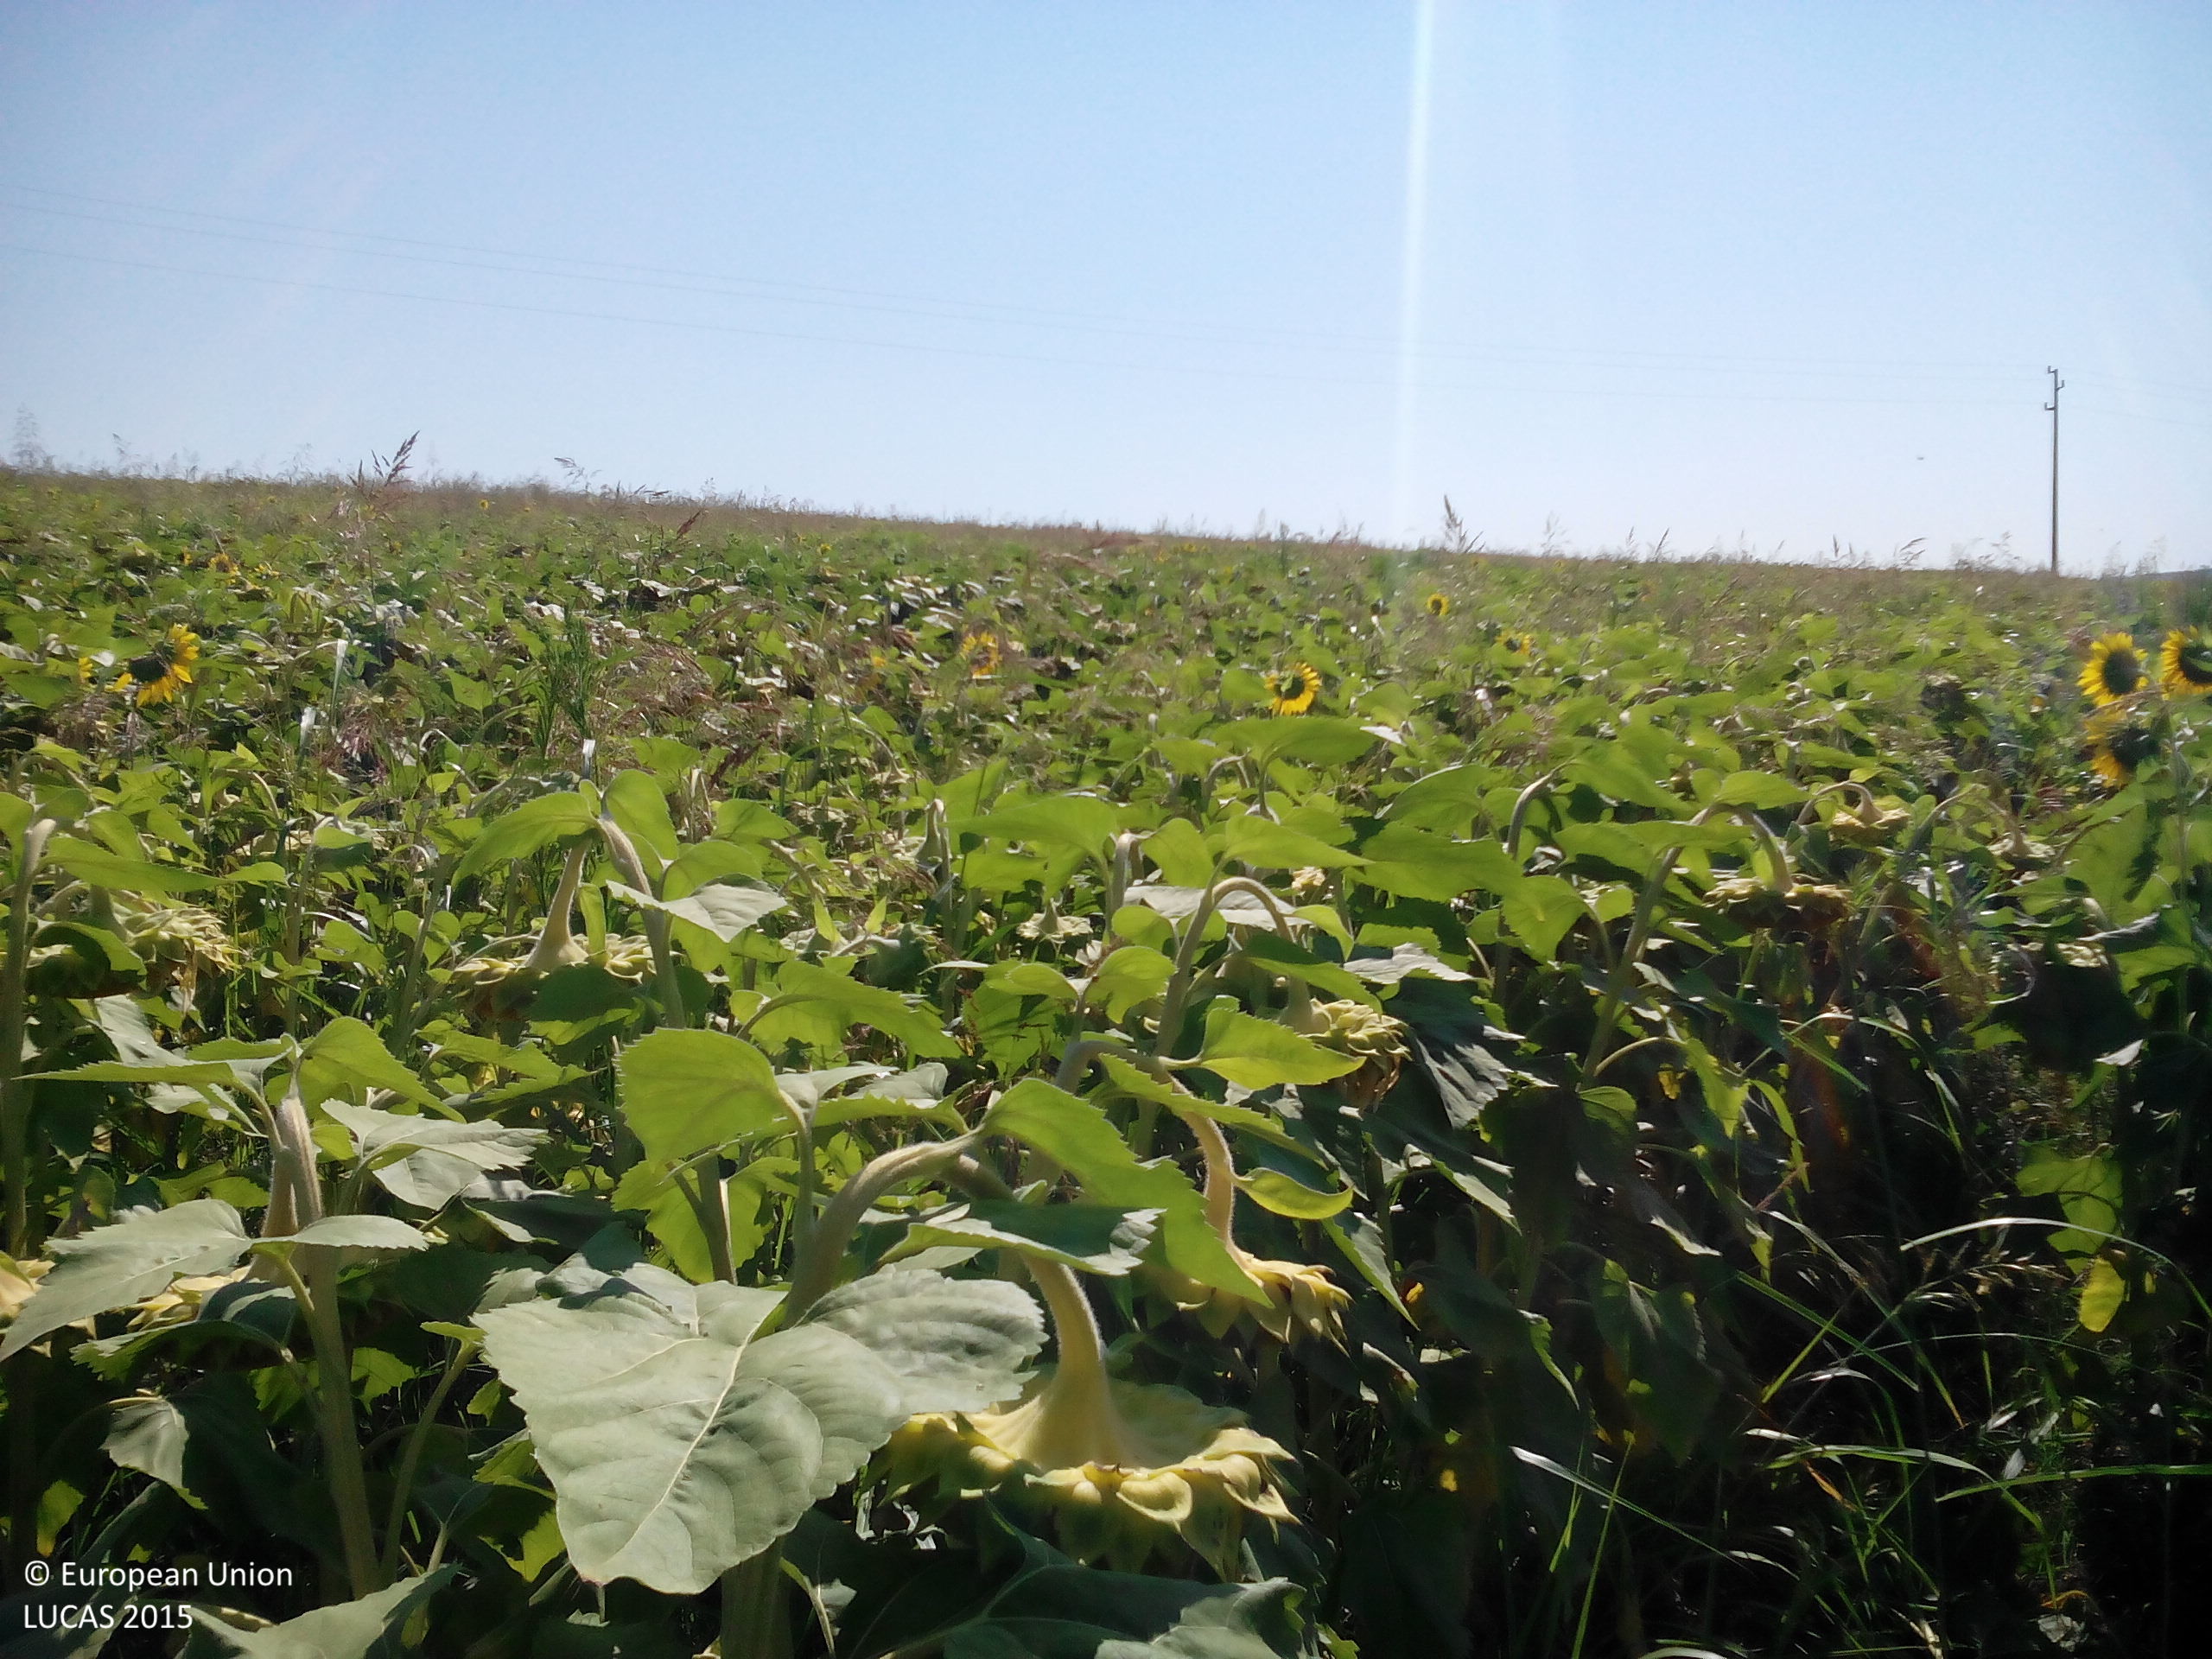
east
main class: Cropland
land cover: Sunflower
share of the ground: > 75 %
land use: Agriculture (excluding fallow land and kitchen gardens)
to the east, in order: Sunflower; Electric lines; Sunflower
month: July
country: BG
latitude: 43.2574
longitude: 24.2077
